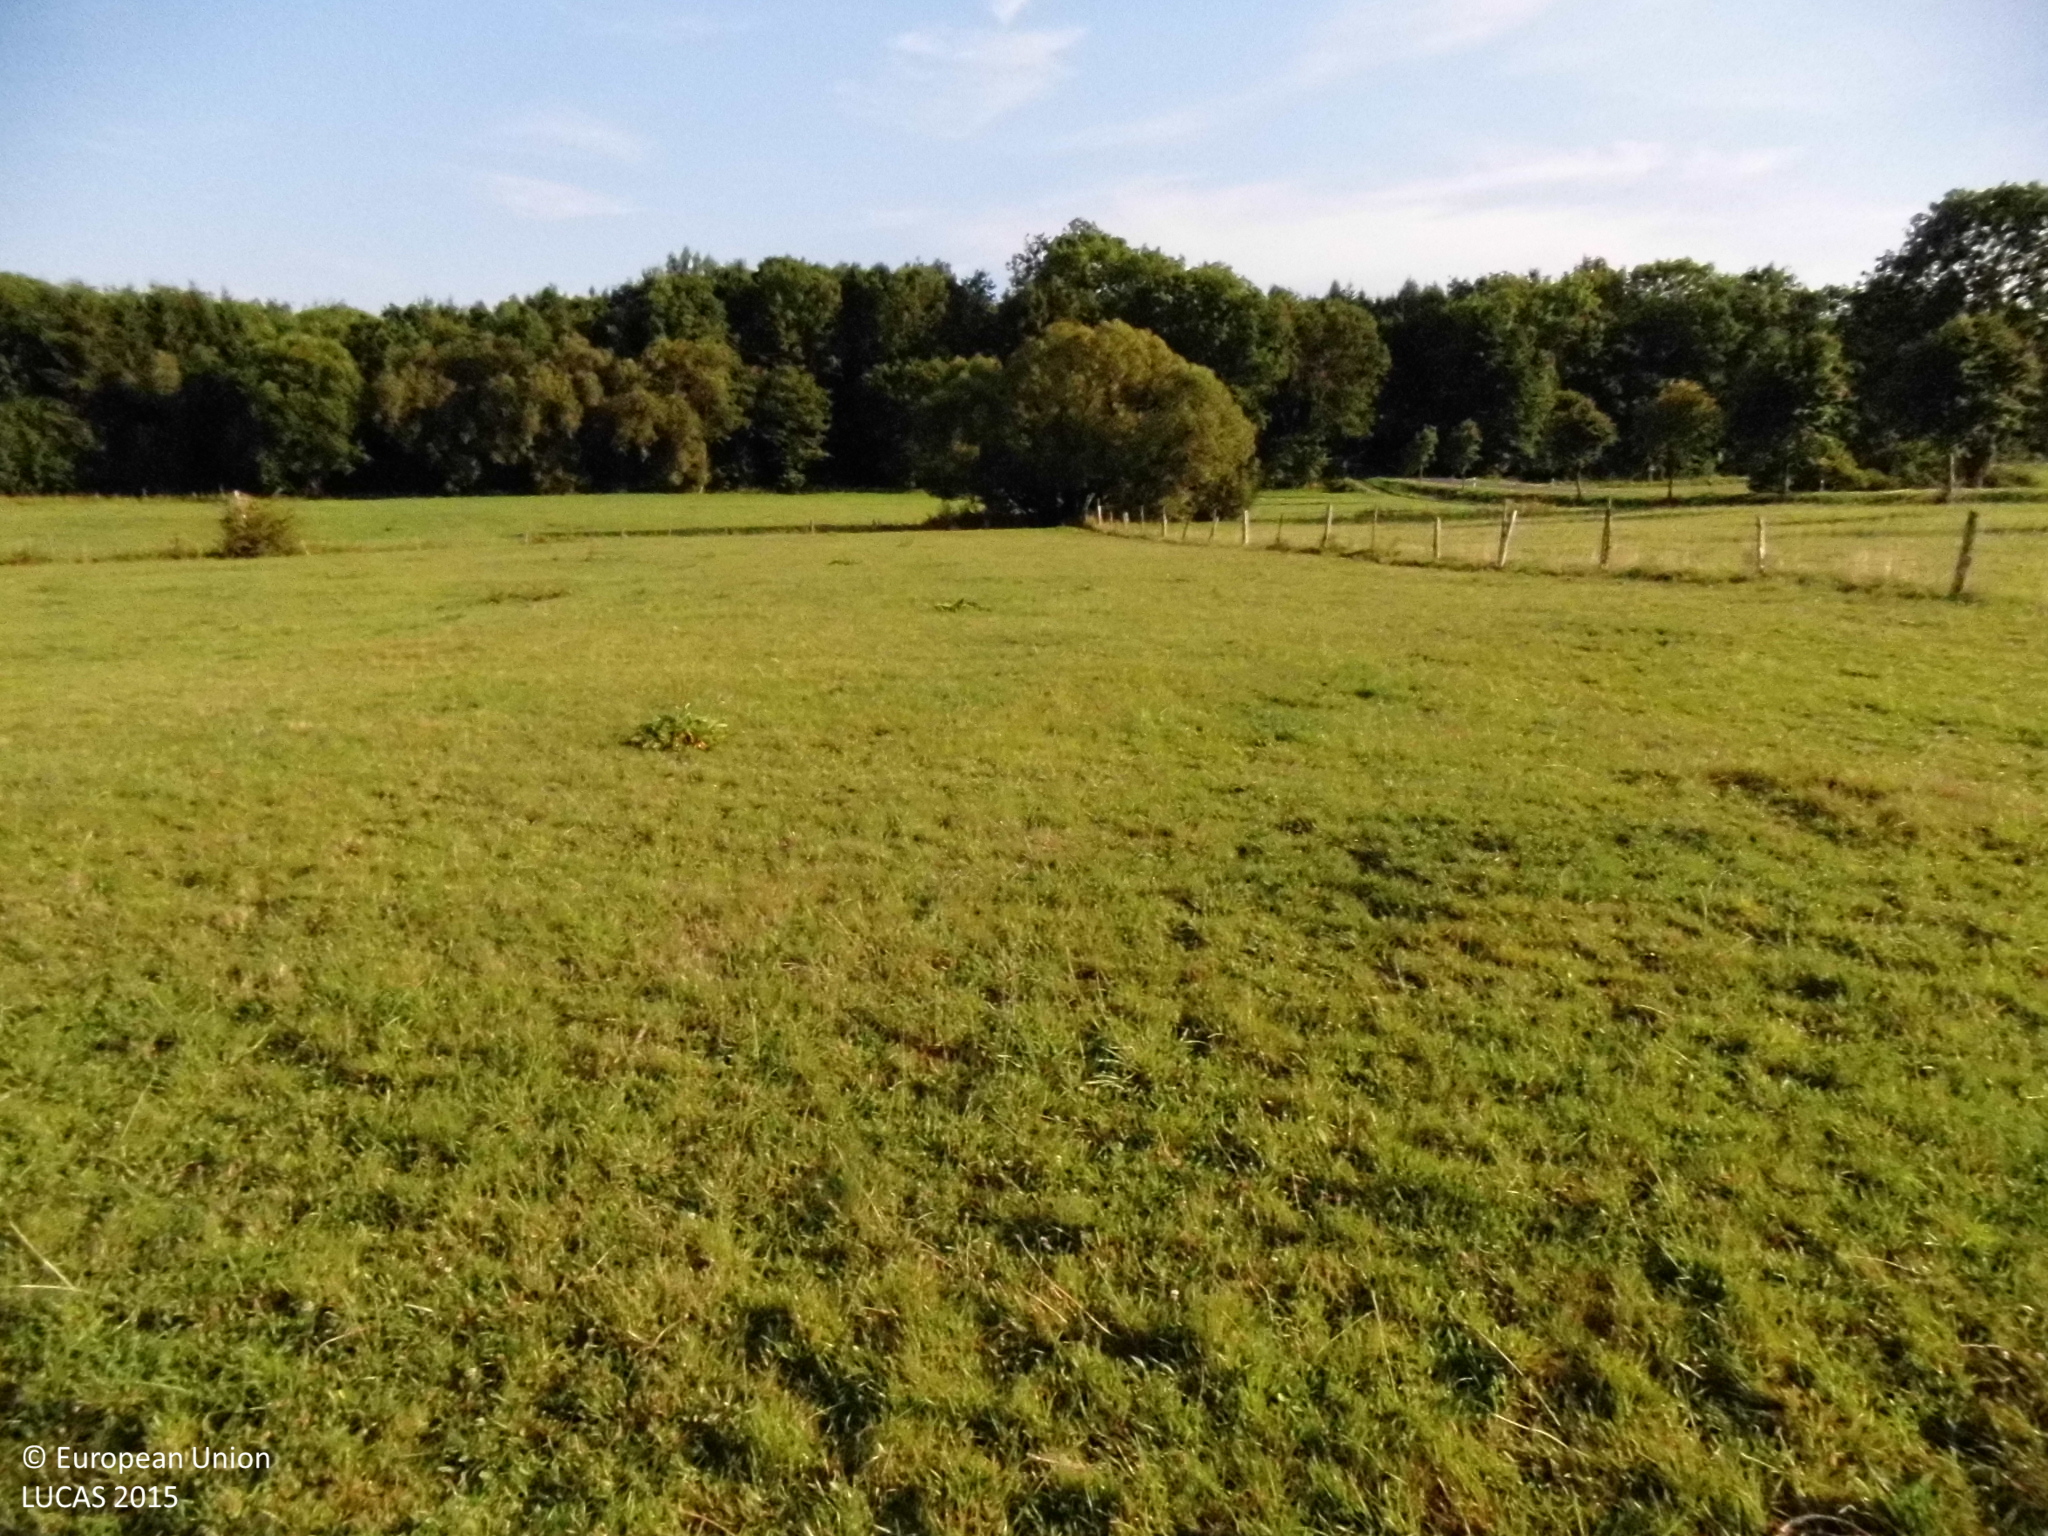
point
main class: Grassland
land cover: Grassland without tree/shrub cover
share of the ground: > 75 %
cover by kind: herbaceous plants 100 %
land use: Agriculture (excluding fallow land and kitchen gardens)
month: August
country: DE
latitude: 50.4921
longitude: 8.0974
